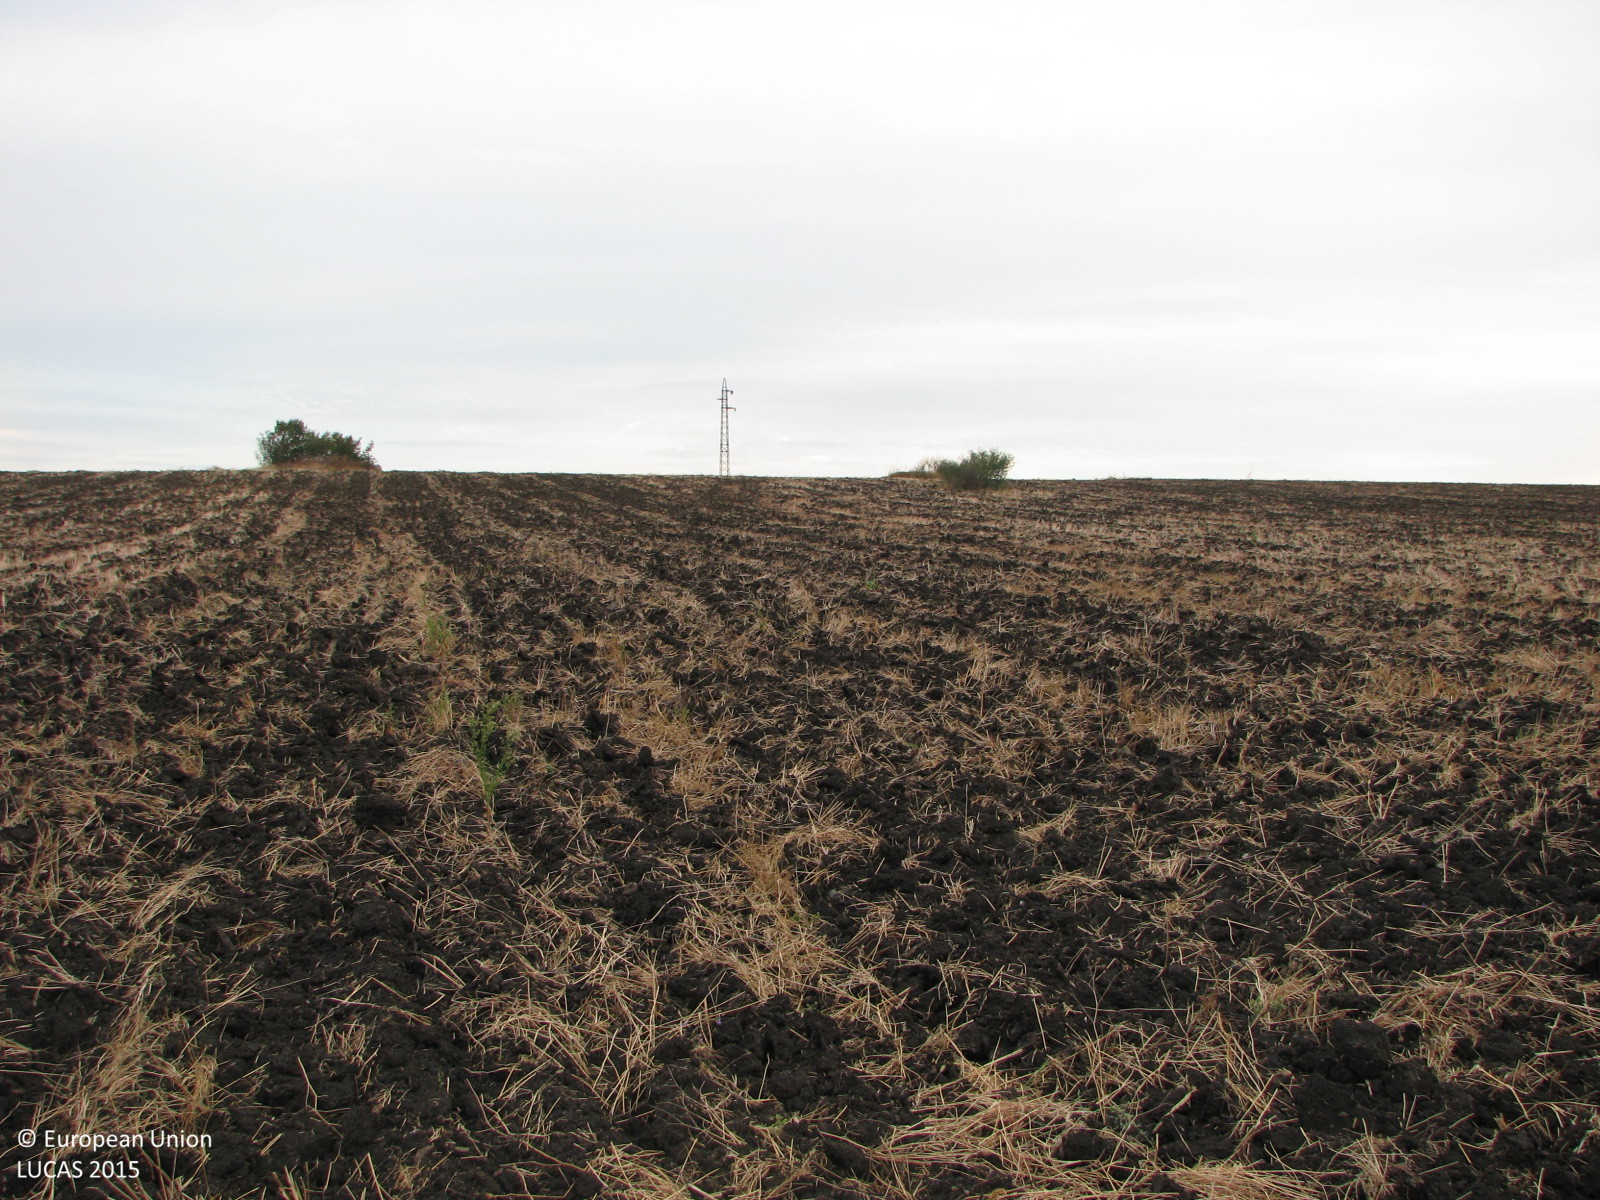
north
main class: Cropland
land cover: Common wheat
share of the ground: < 10 %
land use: Agriculture (excluding fallow land and kitchen gardens)
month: September
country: BG
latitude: 42.4346
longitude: 26.9131
